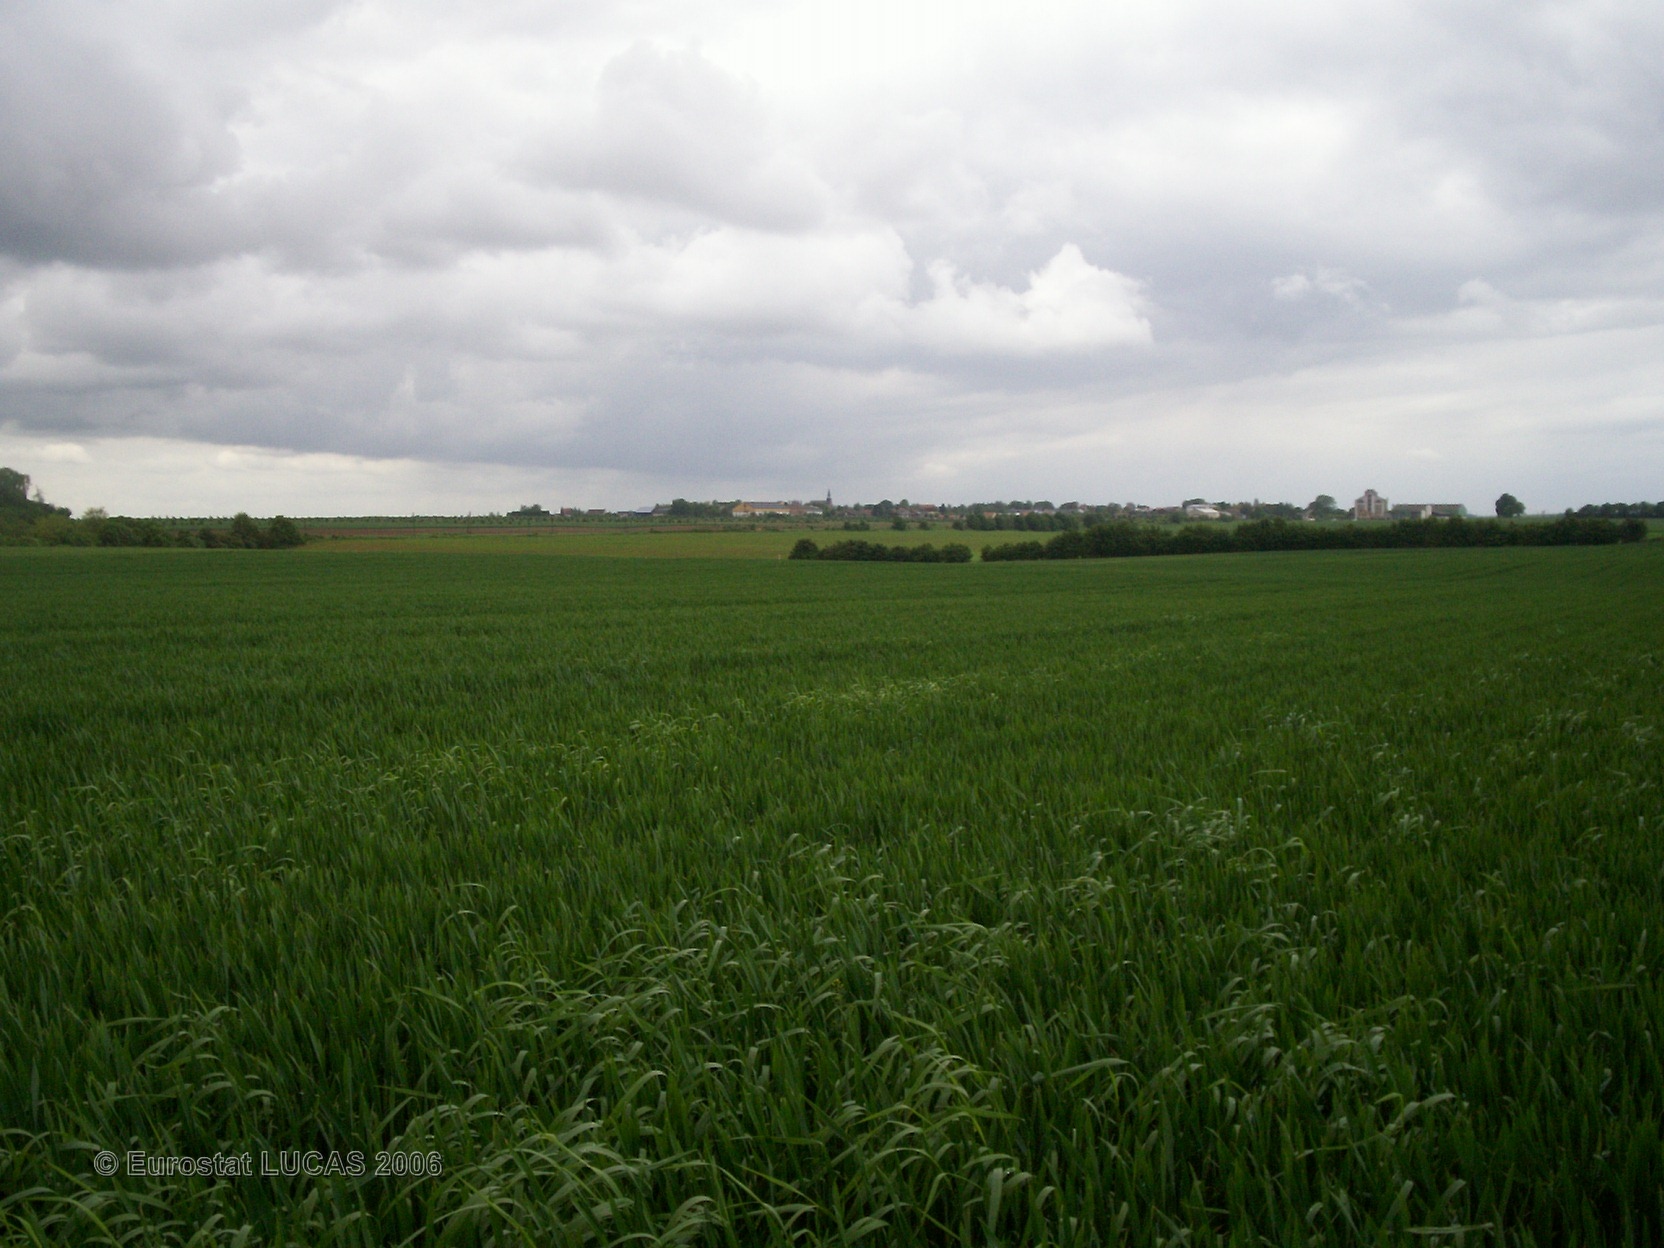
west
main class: Cropland
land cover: Common wheat
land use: Agriculture (excluding fallow land and kitchen gardens)
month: May
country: FR
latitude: 49.8535
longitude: 2.6027
